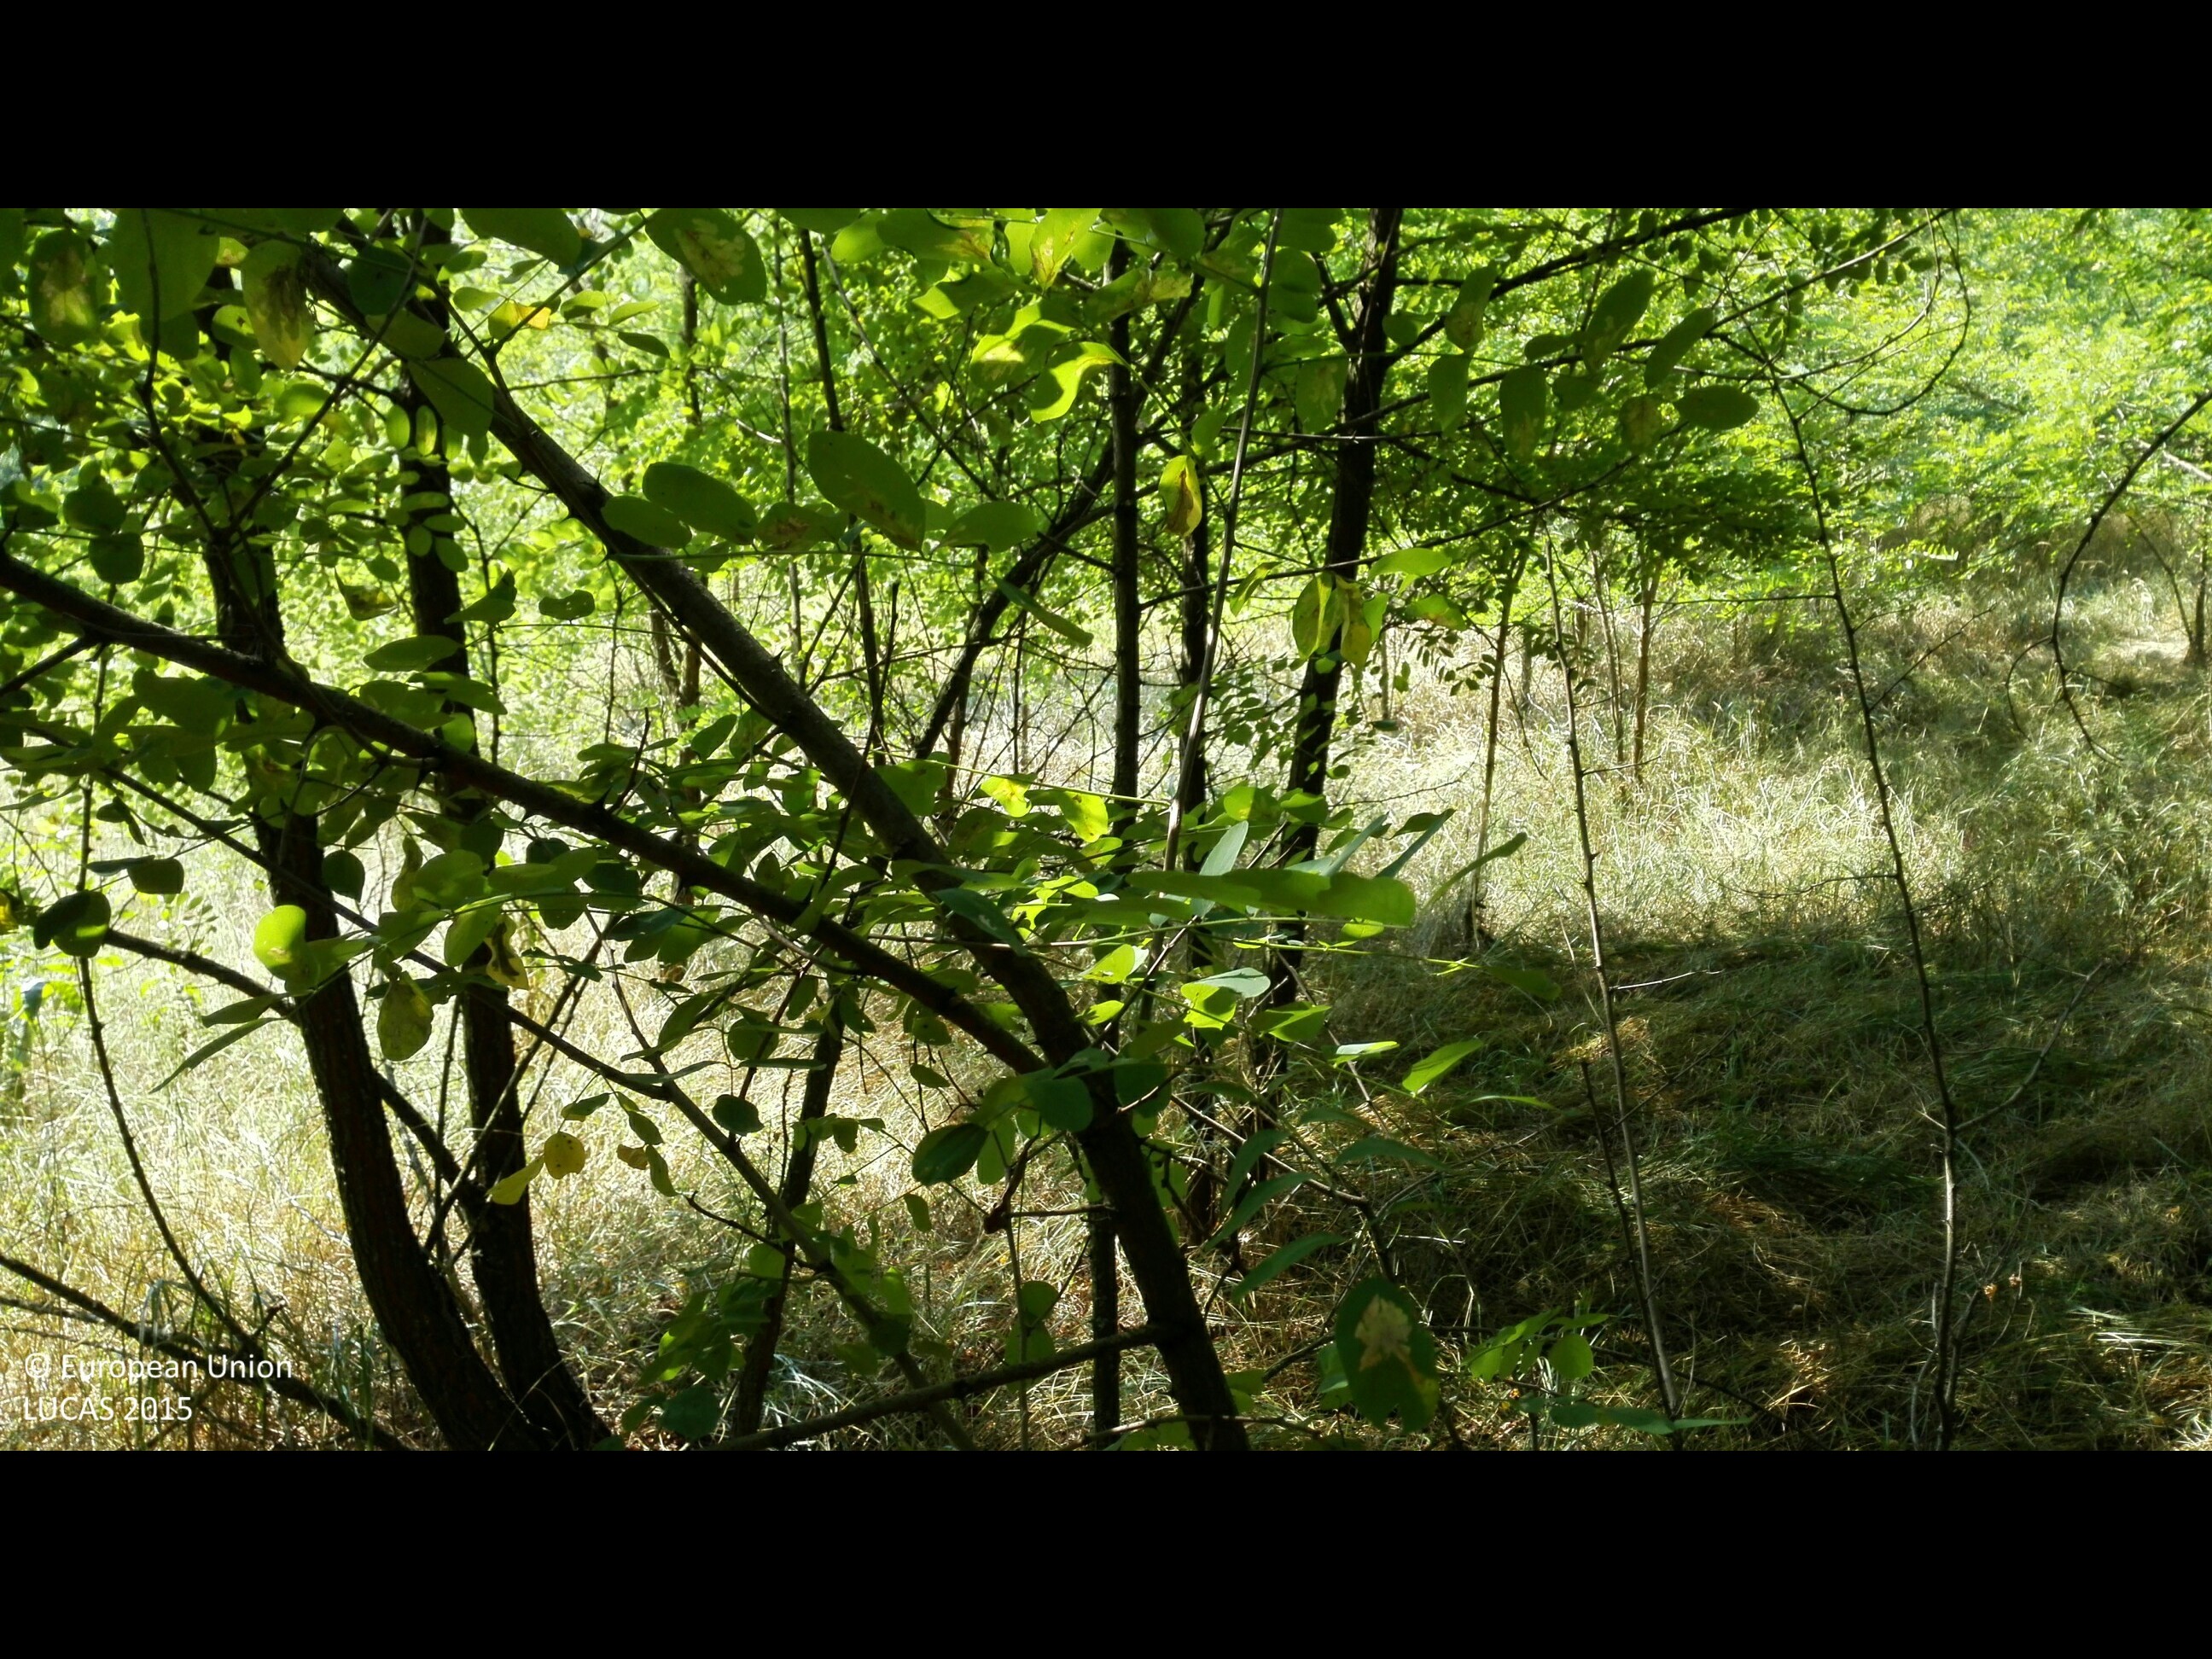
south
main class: Woodland
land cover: Broadleaved woodland
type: exotic forest
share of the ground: > 75 %
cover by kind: broadleaved forest trees 90 %, coniferous forest trees 5 %, herbaceous plants 5 %
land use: Forestry
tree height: > 5 m
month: August
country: HU
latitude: 47.6334
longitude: 22.0421
